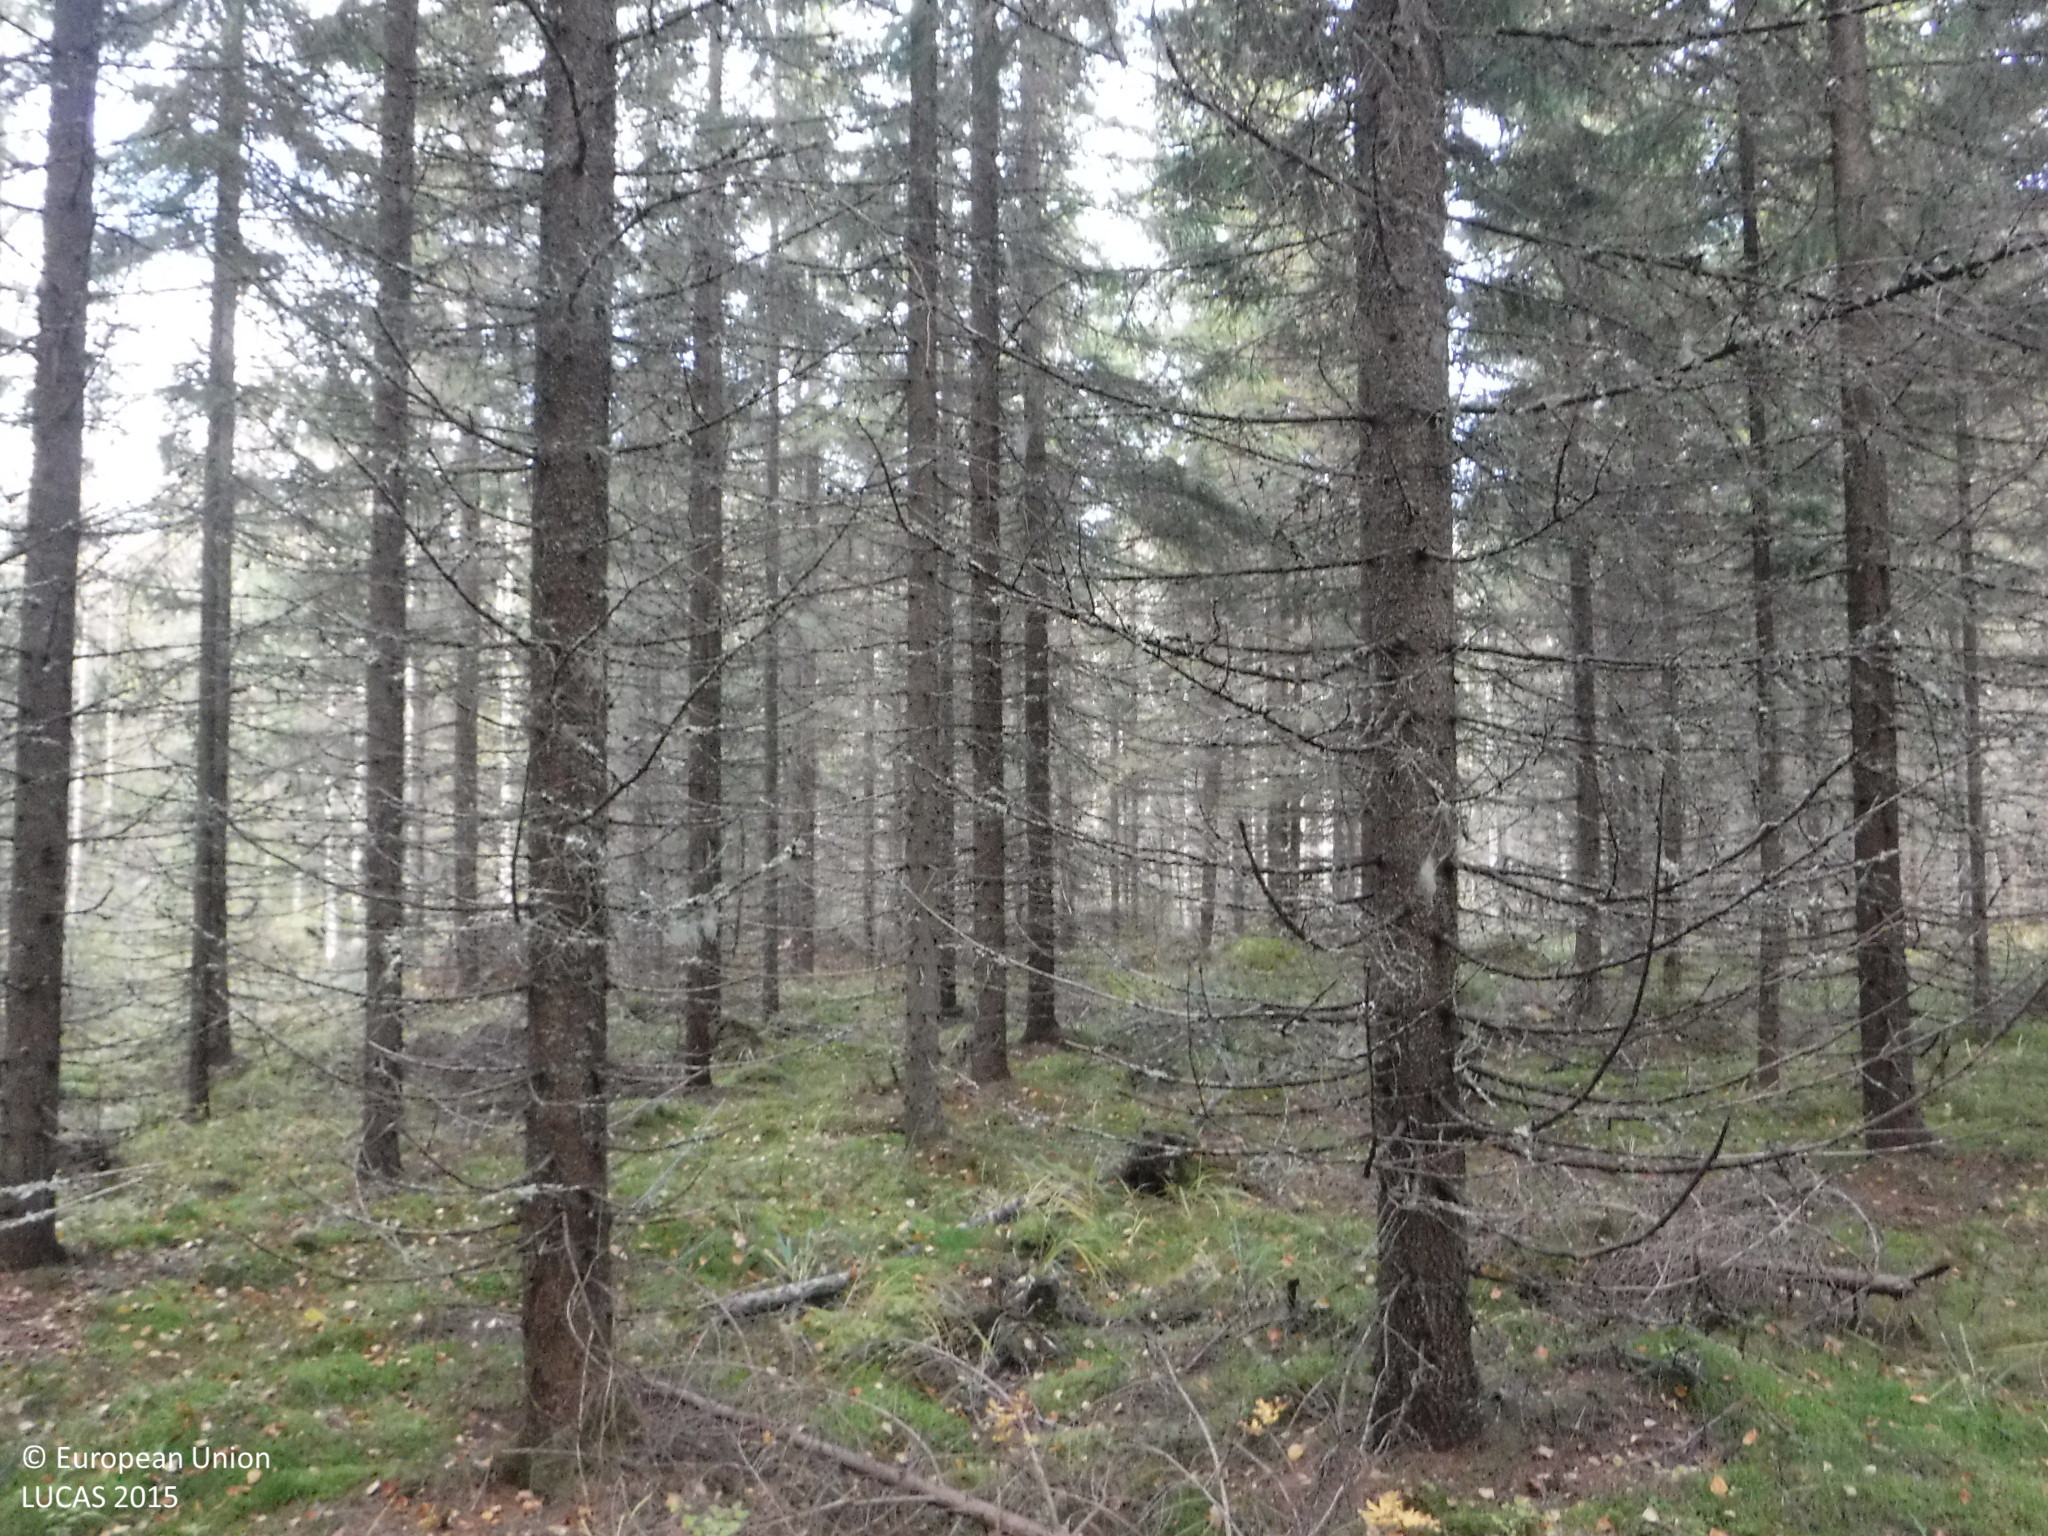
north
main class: Woodland
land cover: Spruce dominated coniferous woodland
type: boreal forest
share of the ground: > 75 %
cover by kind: coniferous forest trees 75 %, lichens and mosses 20 %, shrubs 5 %
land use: Forestry
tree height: > 5 m
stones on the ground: 25 - 50 %
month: October
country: FI
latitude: 61.9758
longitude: 25.9441
